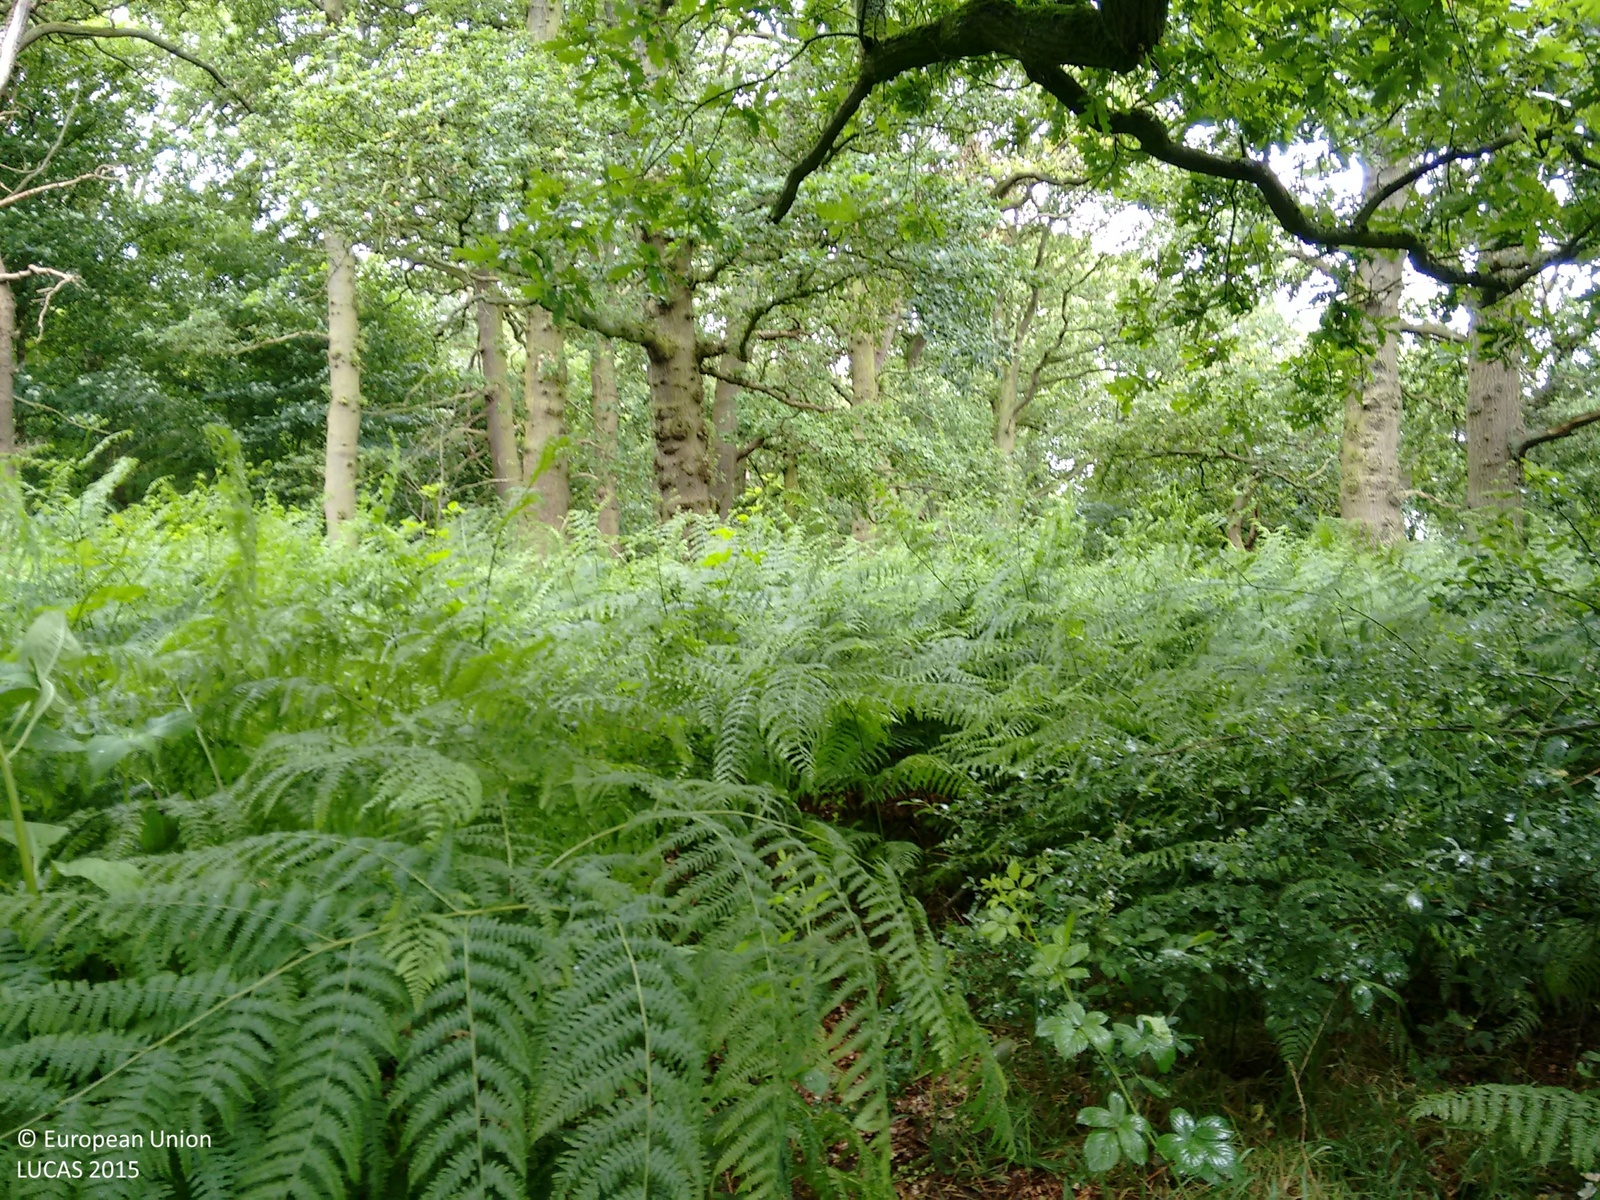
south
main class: Woodland
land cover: Broadleaved woodland
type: mesophytic deciduous forest
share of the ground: > 75 %
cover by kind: broadleaved forest trees 100 %
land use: Semi-natural and natural areas not in use
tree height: > 5 m
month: July
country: GB
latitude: 53.3943
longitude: -2.4409
